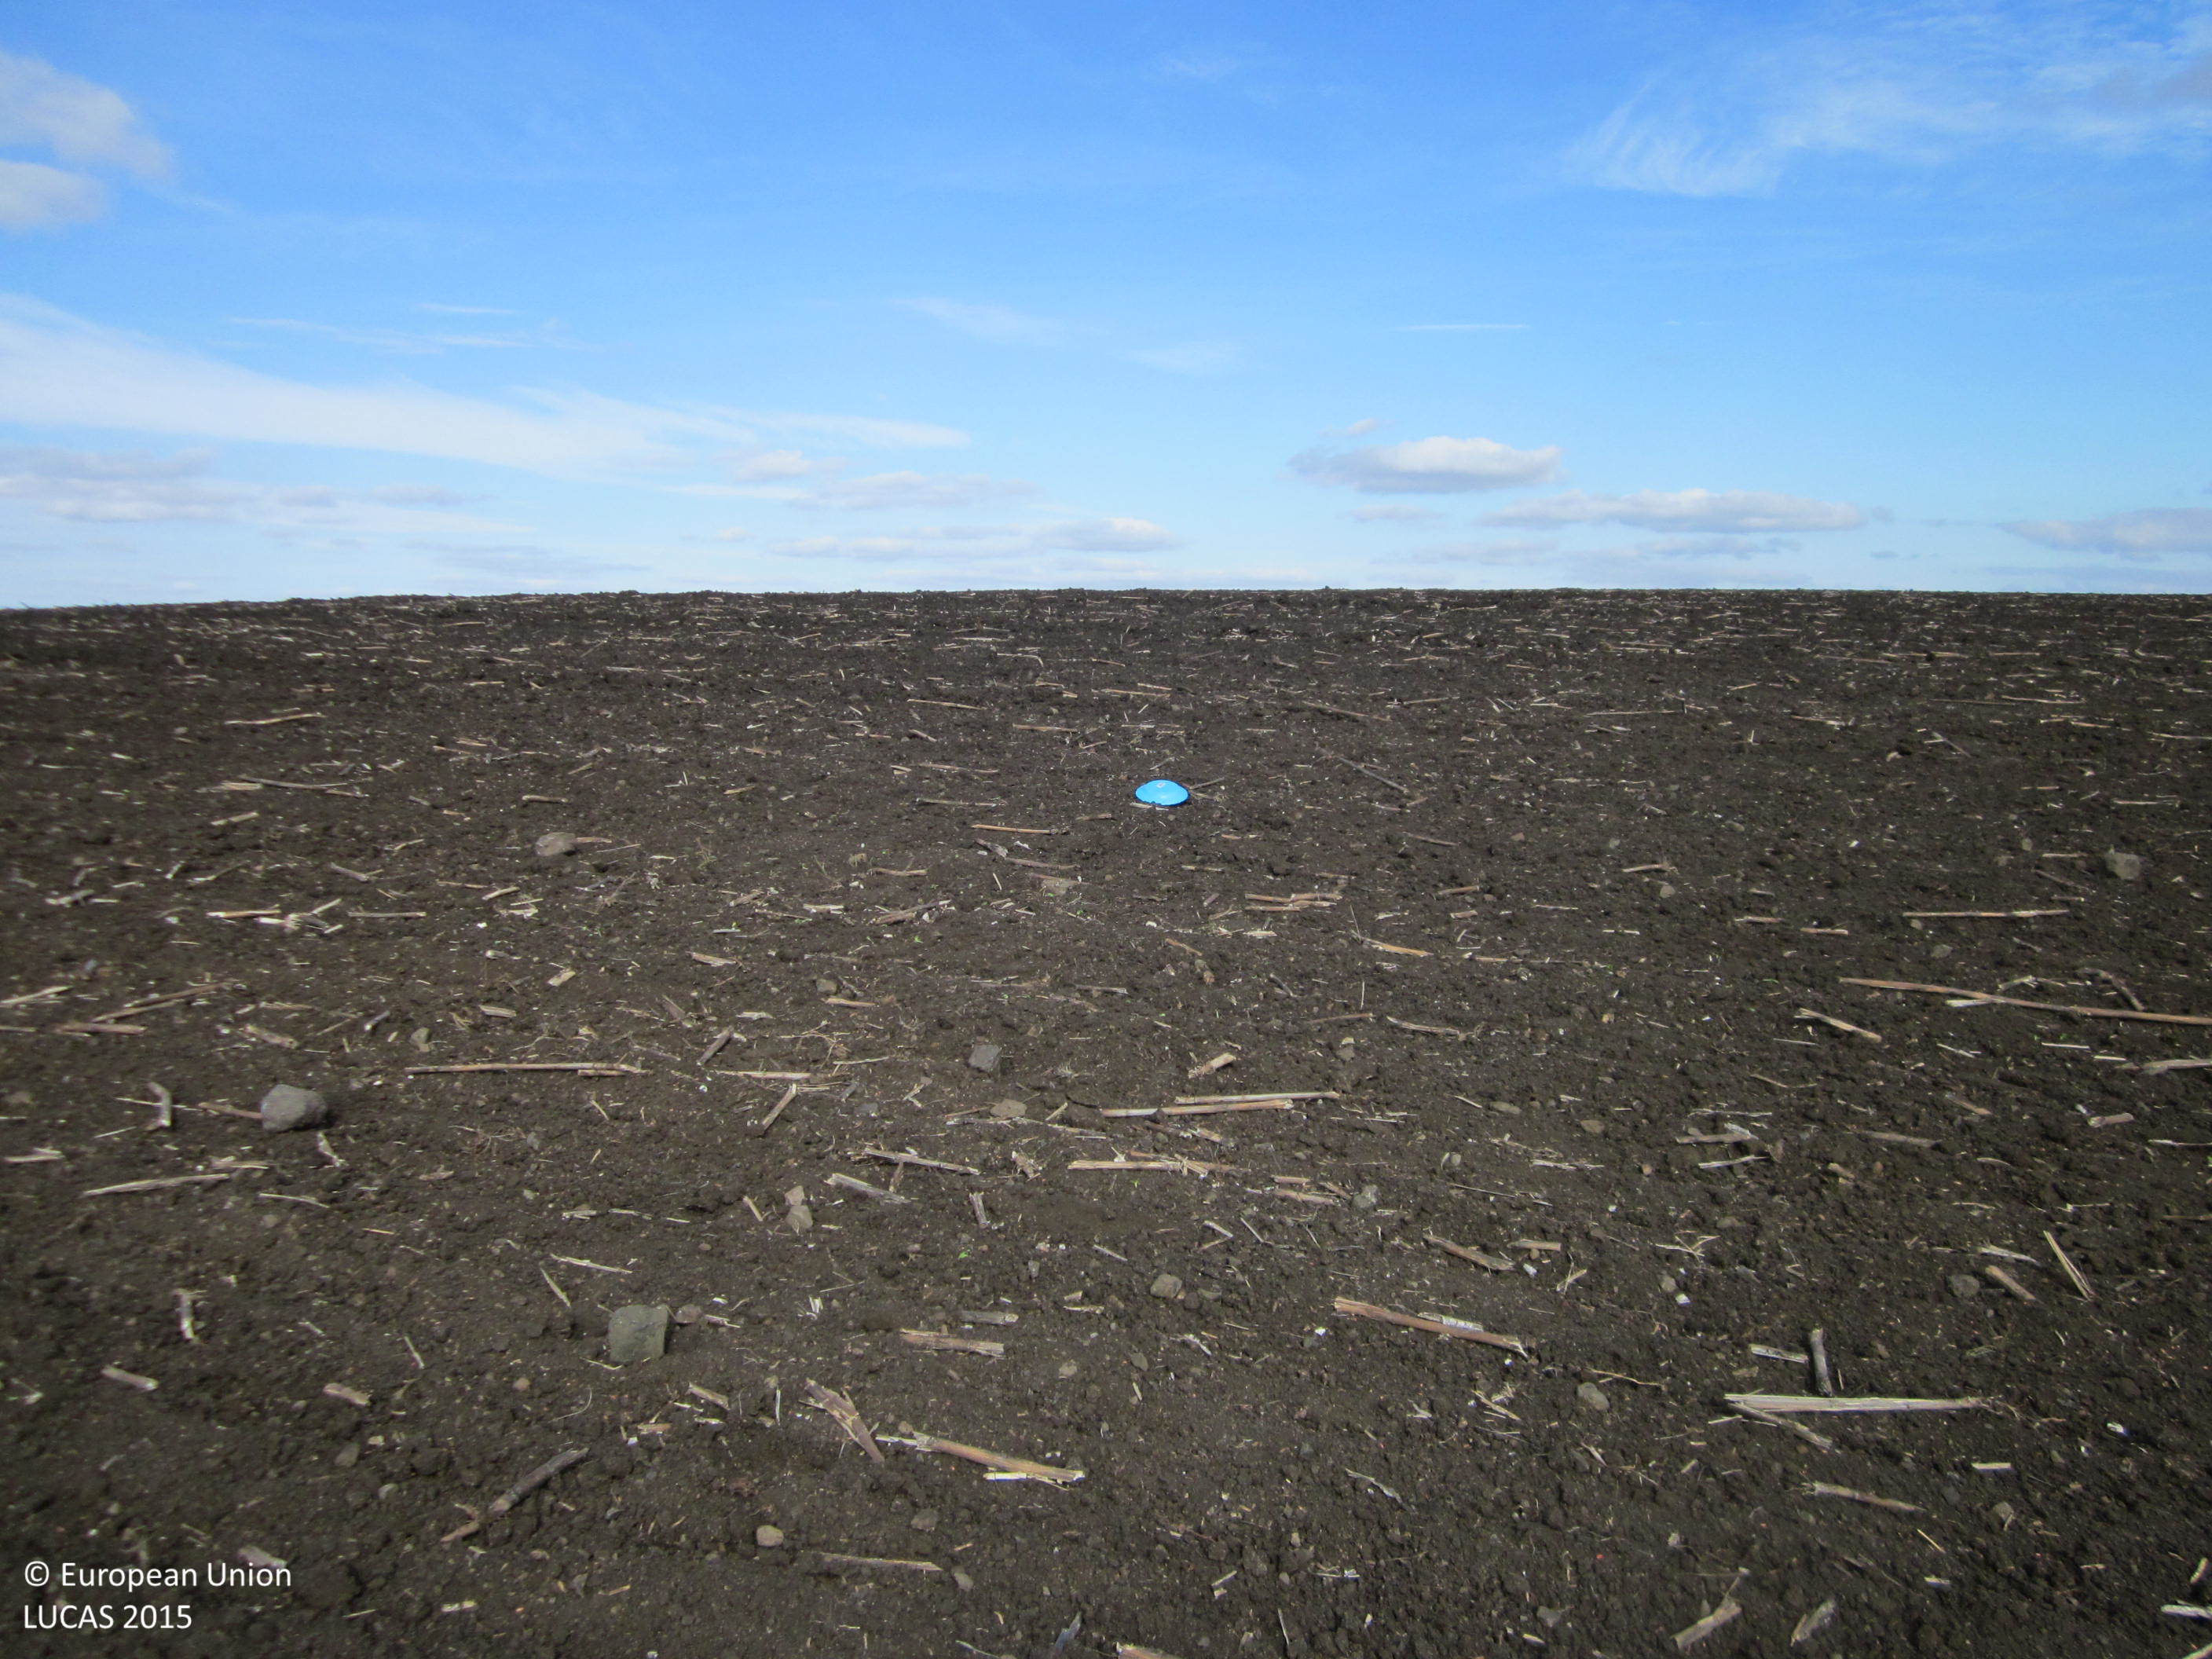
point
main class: Cropland
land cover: Sunflower
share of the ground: < 10 %
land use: Agriculture (excluding fallow land and kitchen gardens)
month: October
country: BG
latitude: 42.4278
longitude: 27.0608
